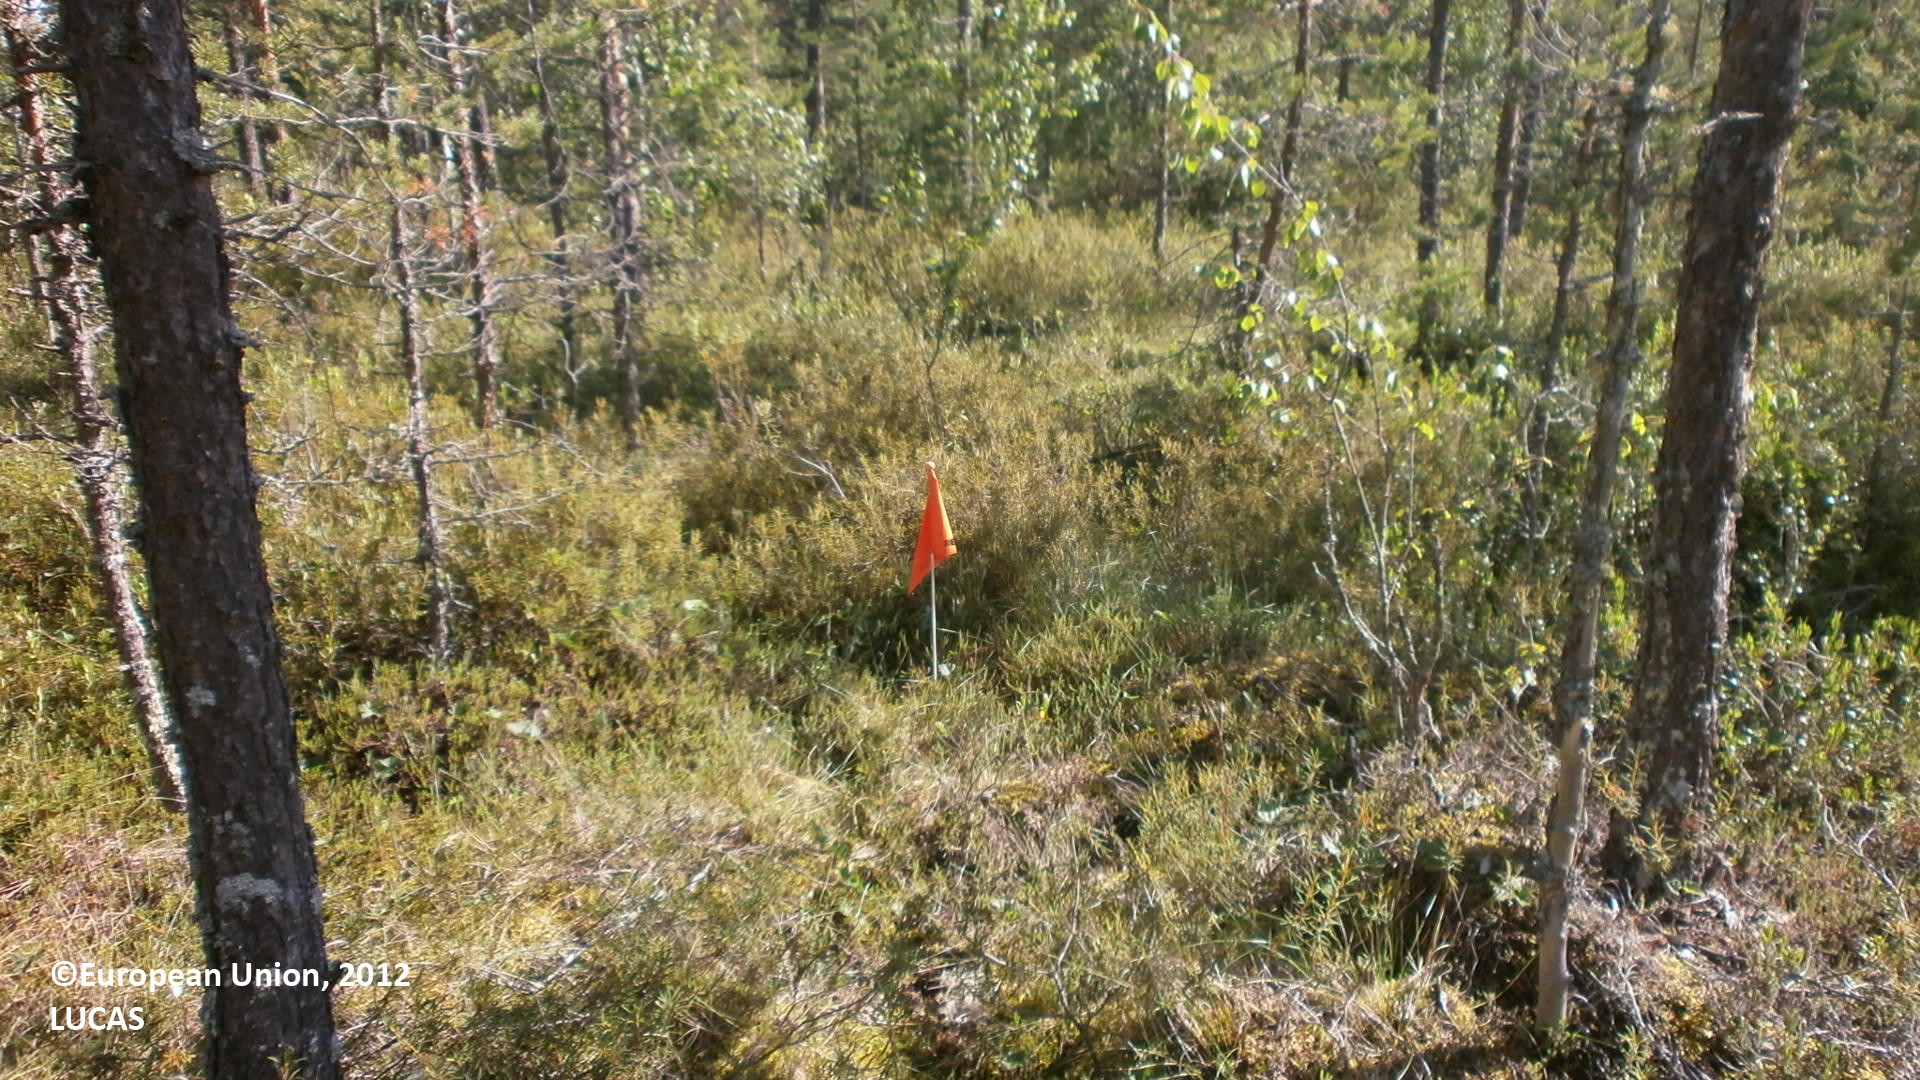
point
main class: Woodland
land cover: Pine dominated coniferous woodland
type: boreal forest
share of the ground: 25 - 50 %
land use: Forestry
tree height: > 5 m
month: July
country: FI
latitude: 64.4490
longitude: 24.4695
